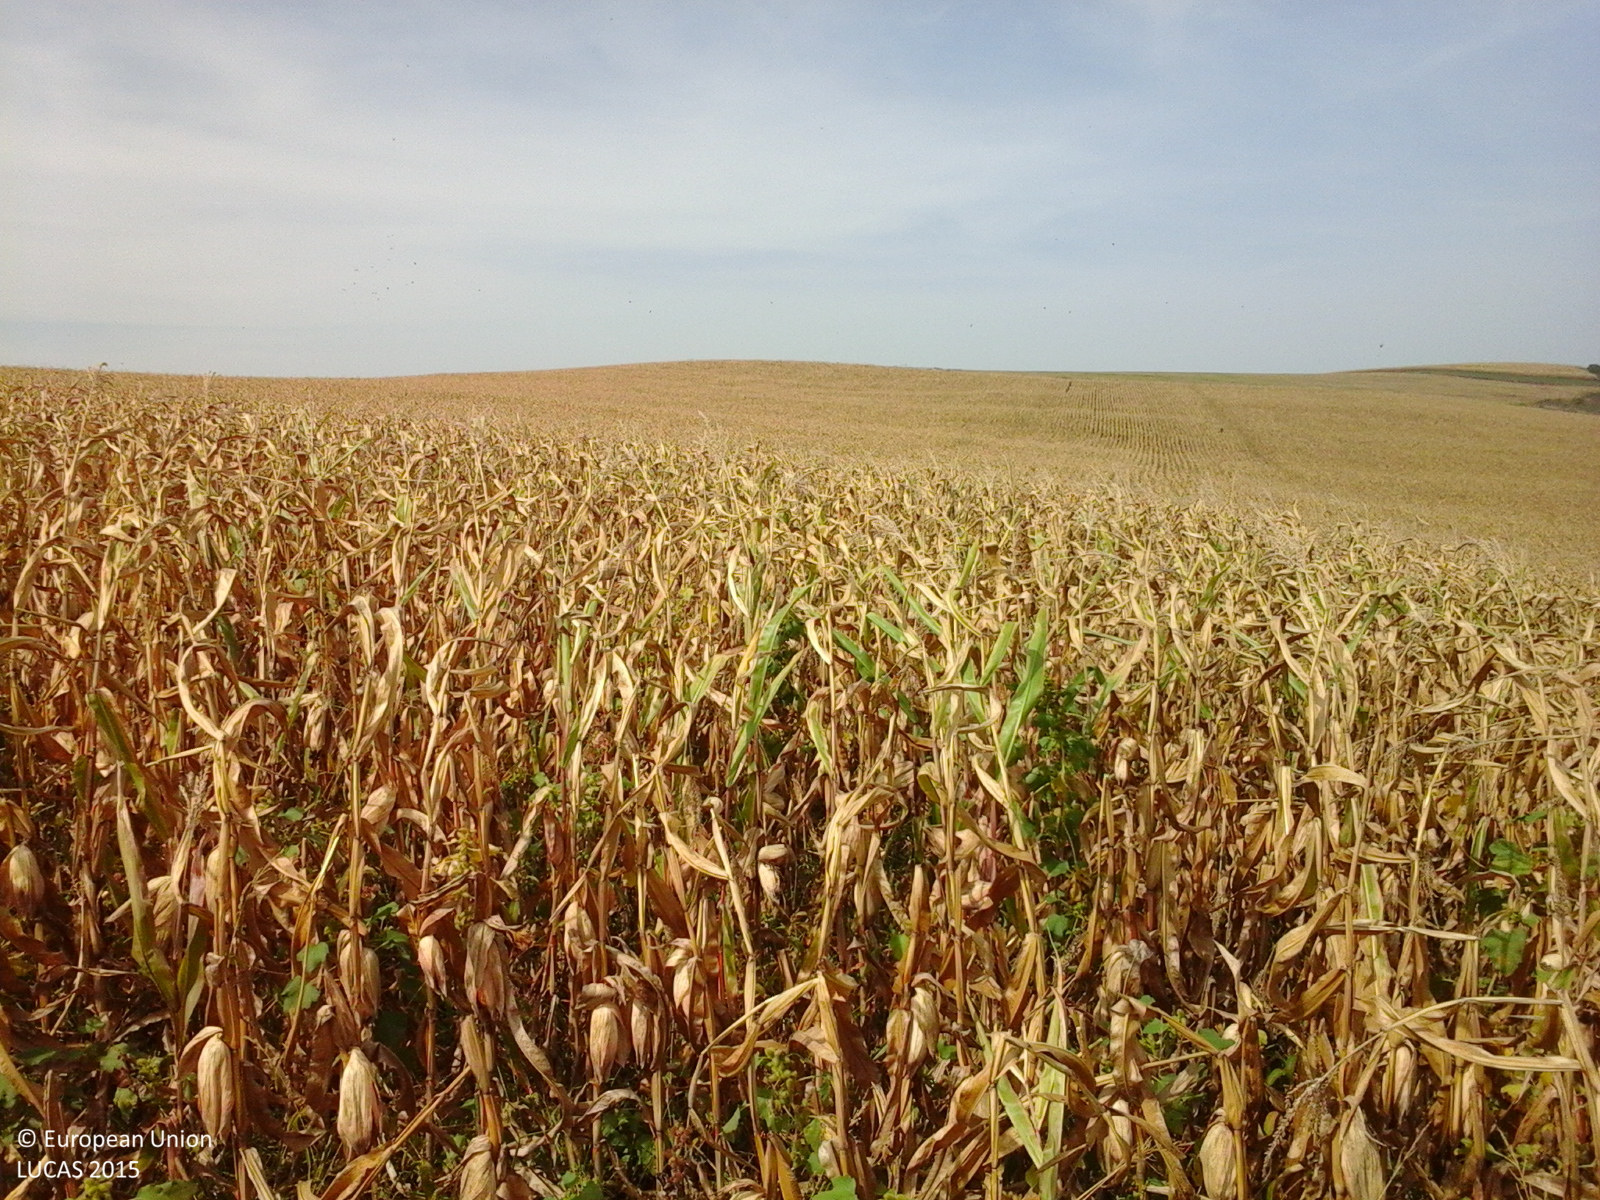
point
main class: Cropland
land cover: Maize
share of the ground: > 75 %
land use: Agriculture (excluding fallow land and kitchen gardens)
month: September
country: RO
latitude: 46.8135
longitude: 23.7166
